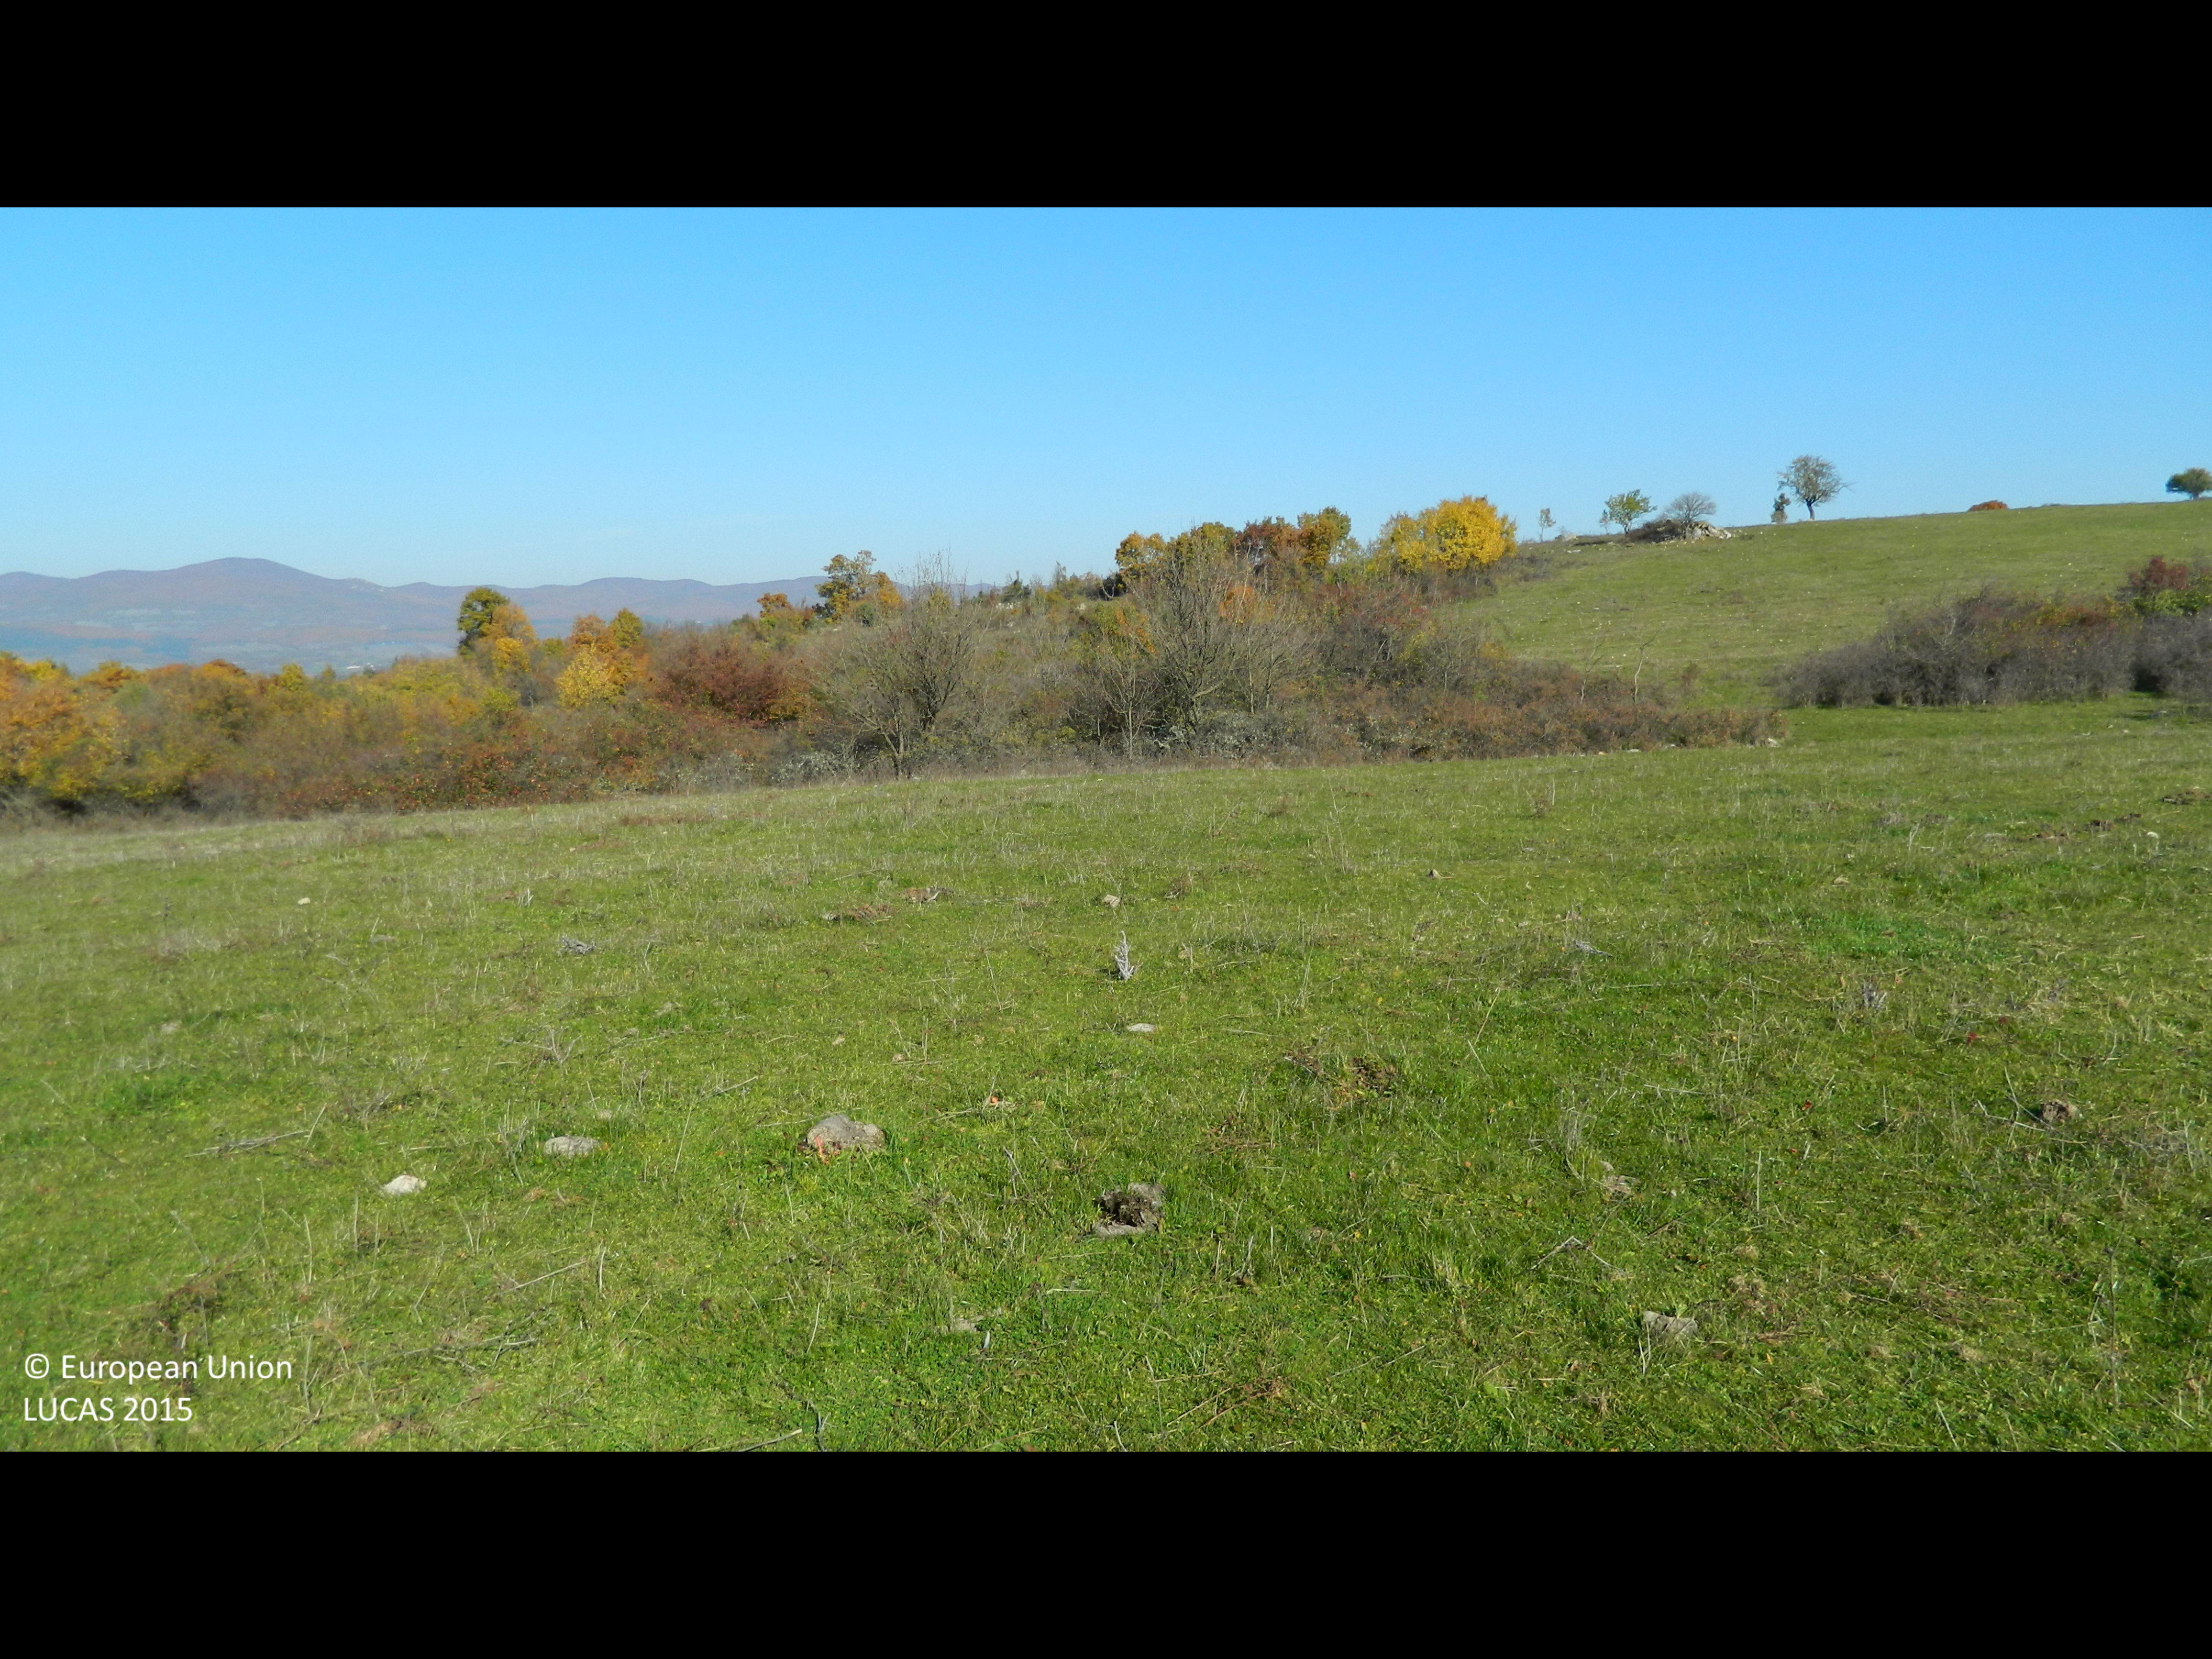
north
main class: Grassland
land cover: Grassland without tree/shrub cover
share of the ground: > 75 %
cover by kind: herbaceous plants 100 %
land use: Agriculture (excluding fallow land and kitchen gardens)
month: November
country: BG
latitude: 41.6200
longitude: 25.9464
